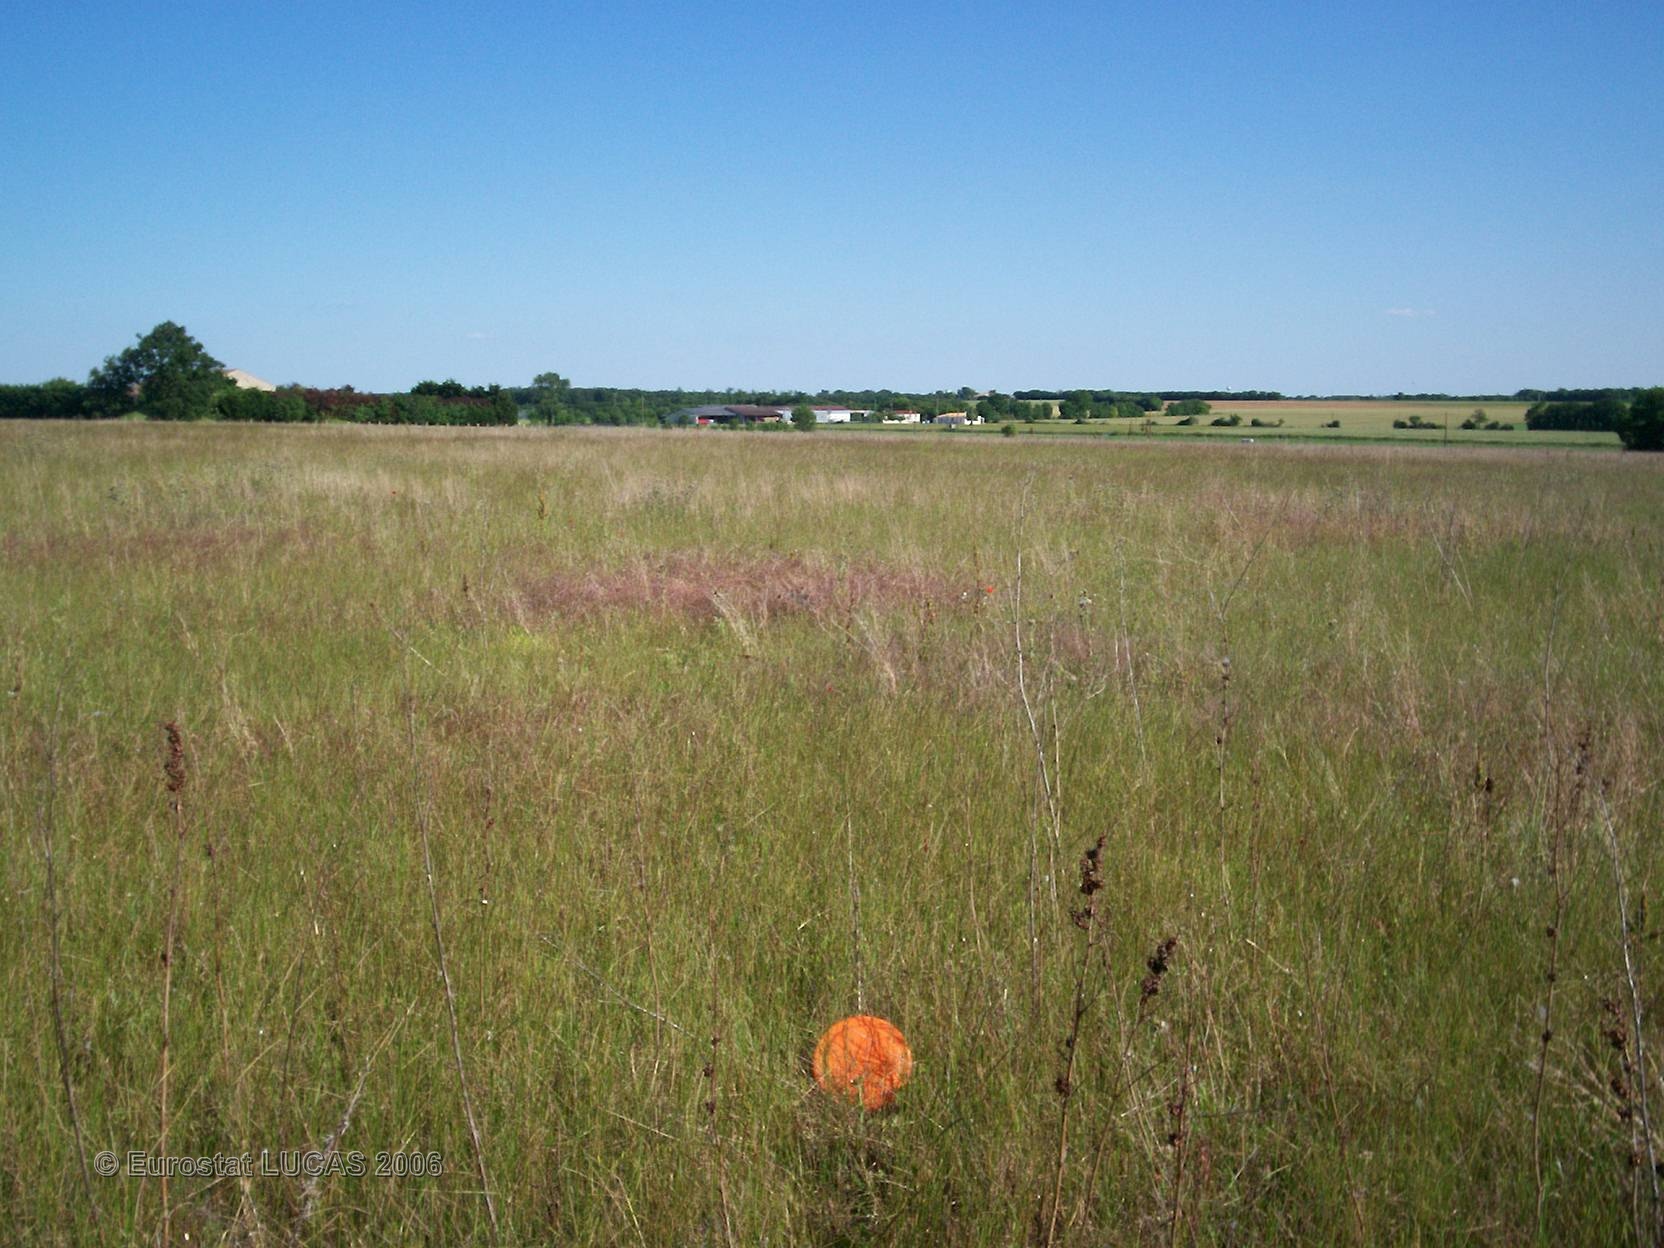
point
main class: Grassland
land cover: Grassland without tree/shrub cover
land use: Agriculture (excluding fallow land and kitchen gardens)
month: June
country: FR
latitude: 46.1518
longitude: -0.7613
